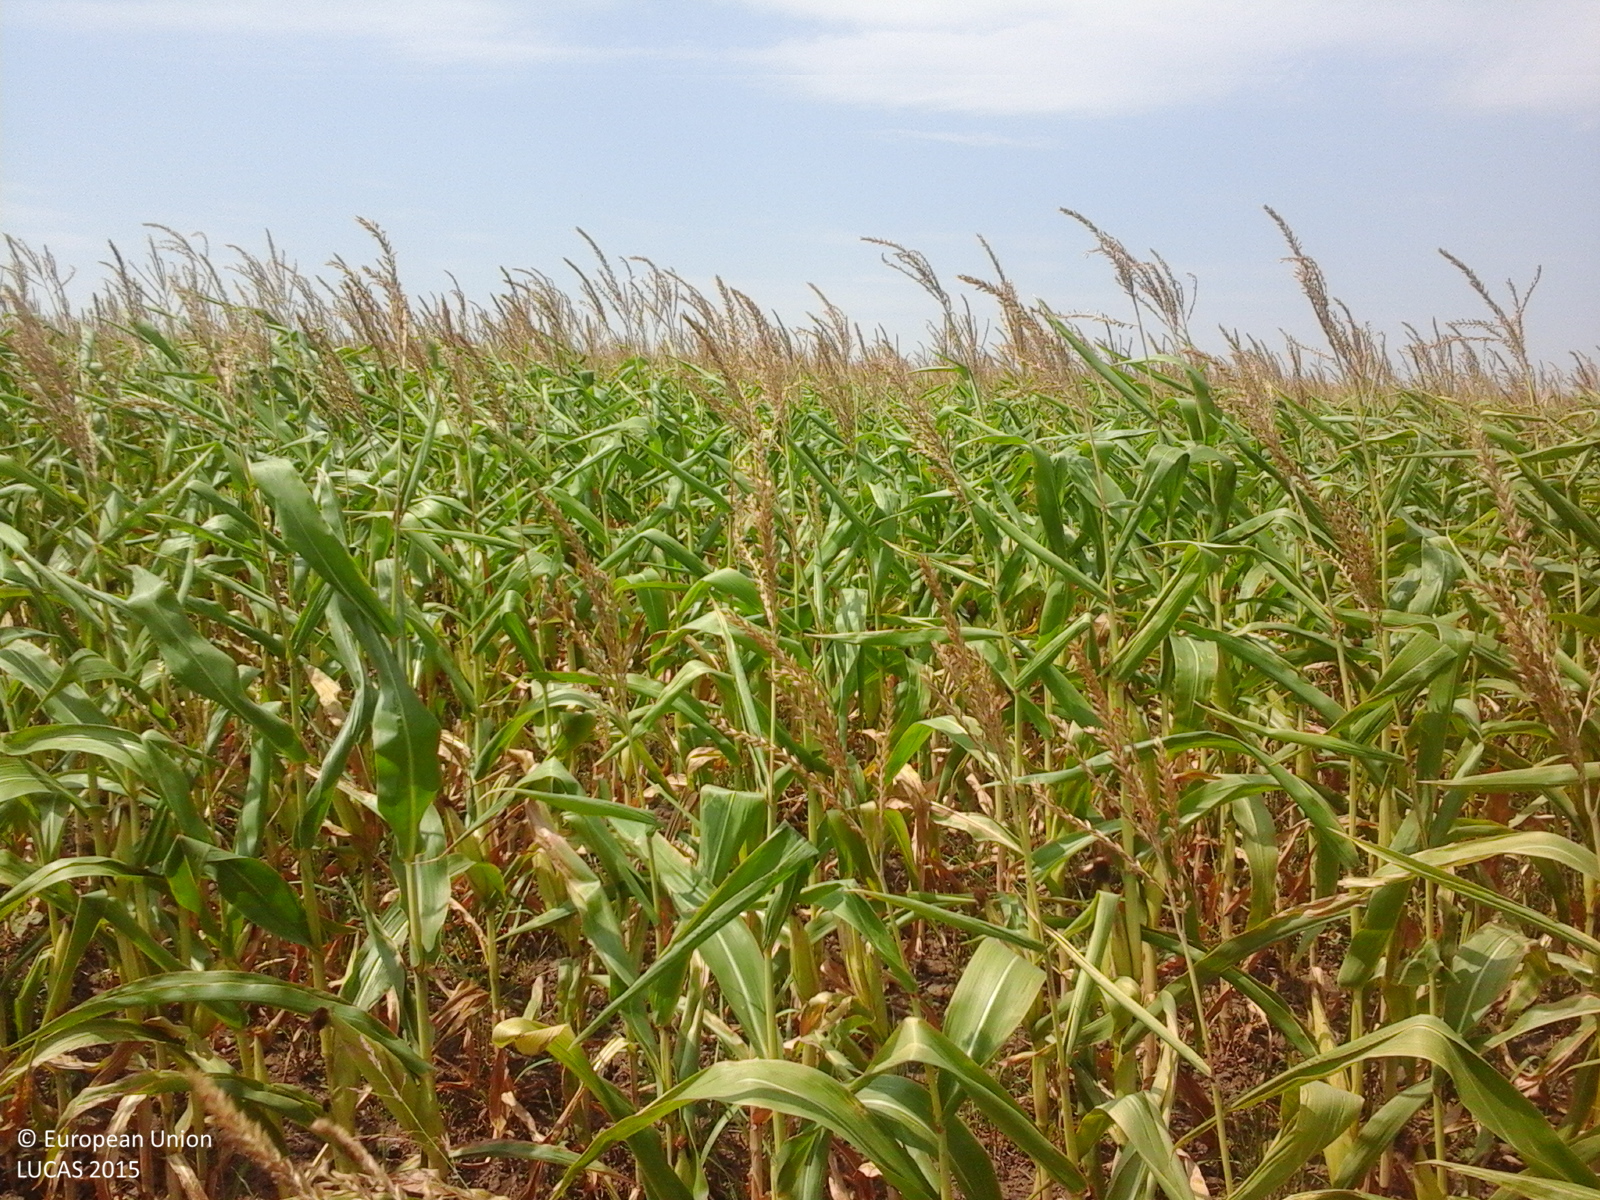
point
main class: Cropland
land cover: Maize
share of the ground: > 75 %
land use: Agriculture (excluding fallow land and kitchen gardens)
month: August
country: RO
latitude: 43.8967
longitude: 28.0415
